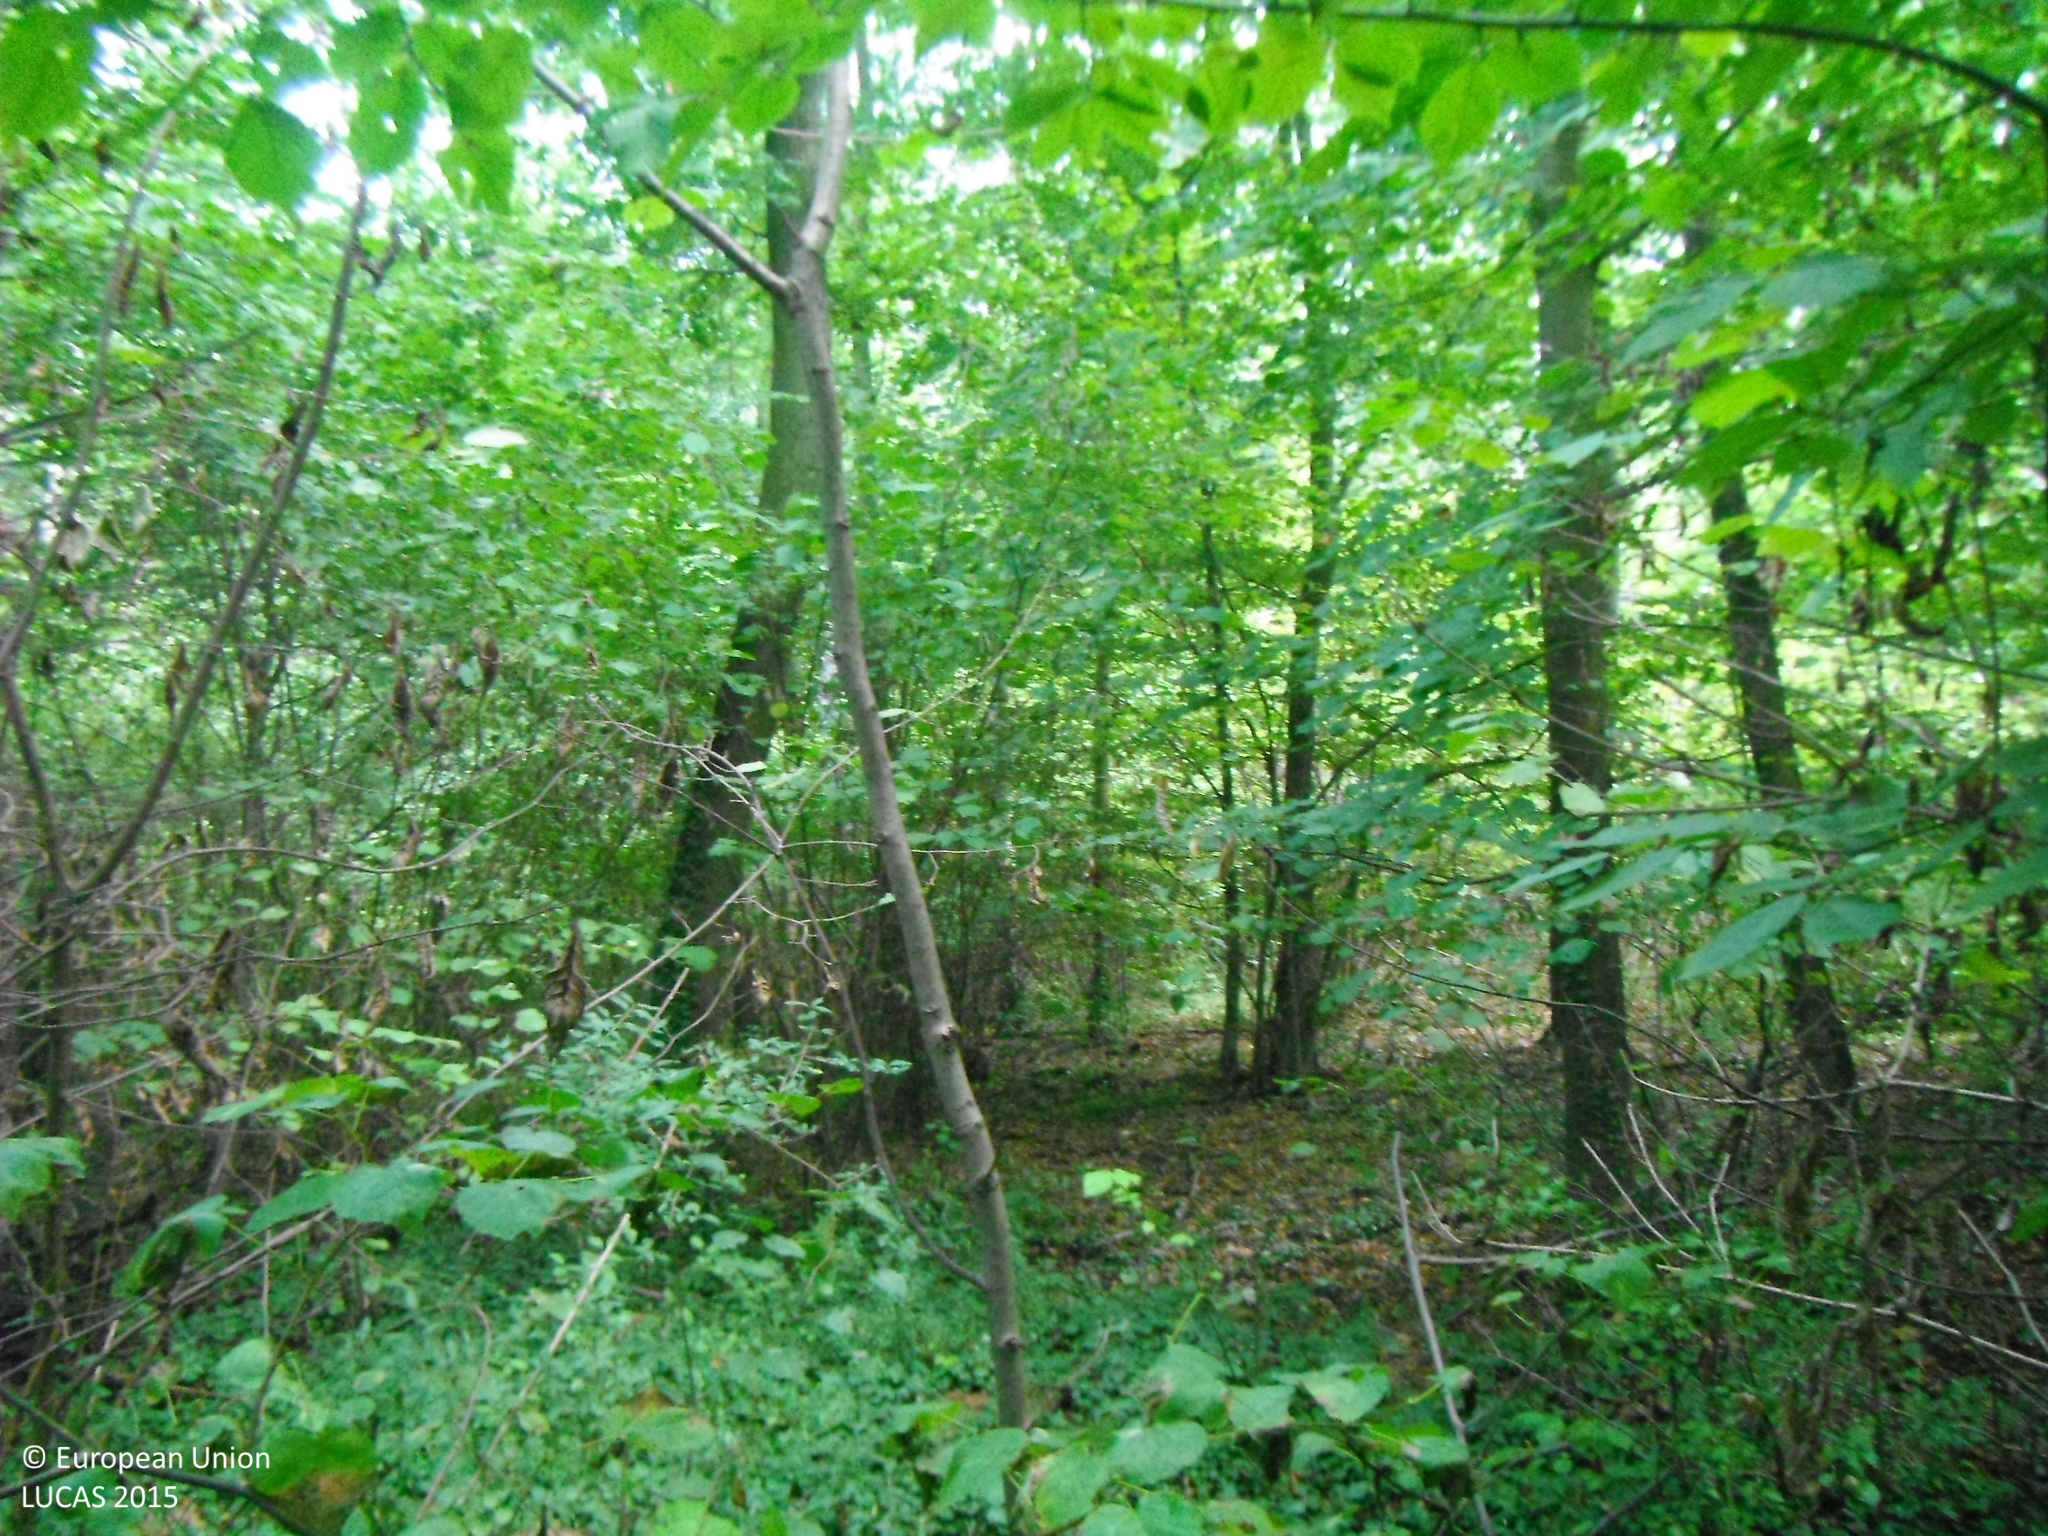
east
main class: Woodland
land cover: Broadleaved woodland
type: mesophytic deciduous forest
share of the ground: > 75 %
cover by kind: broadleaved forest trees 100 %
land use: Forestry
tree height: > 5 m
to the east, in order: Broadleaved woodland
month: September
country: SK
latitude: 48.9230
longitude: 18.0532
